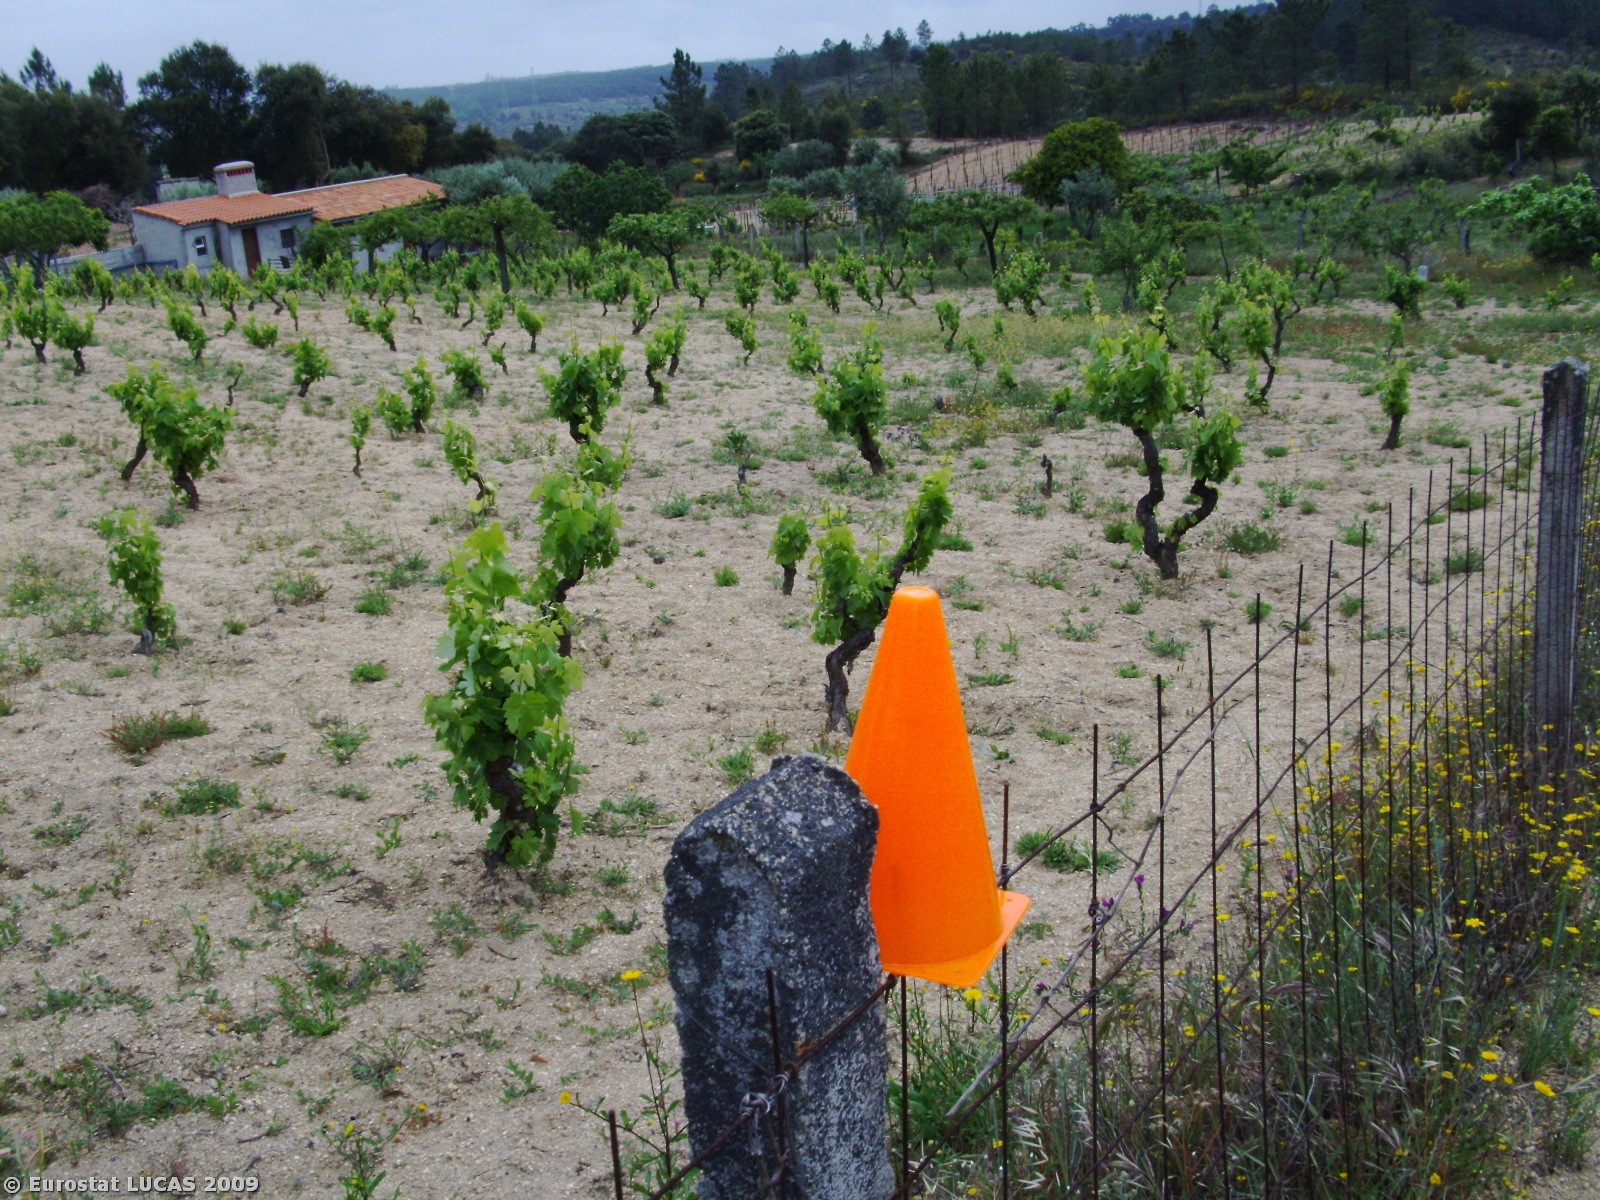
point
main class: Cropland
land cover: Vineyards
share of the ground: 10 - 25 %
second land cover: Bare land
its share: > 75 %
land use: Agriculture (excluding fallow land and kitchen gardens)
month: April
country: PT
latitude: 39.8702
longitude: -7.5563
